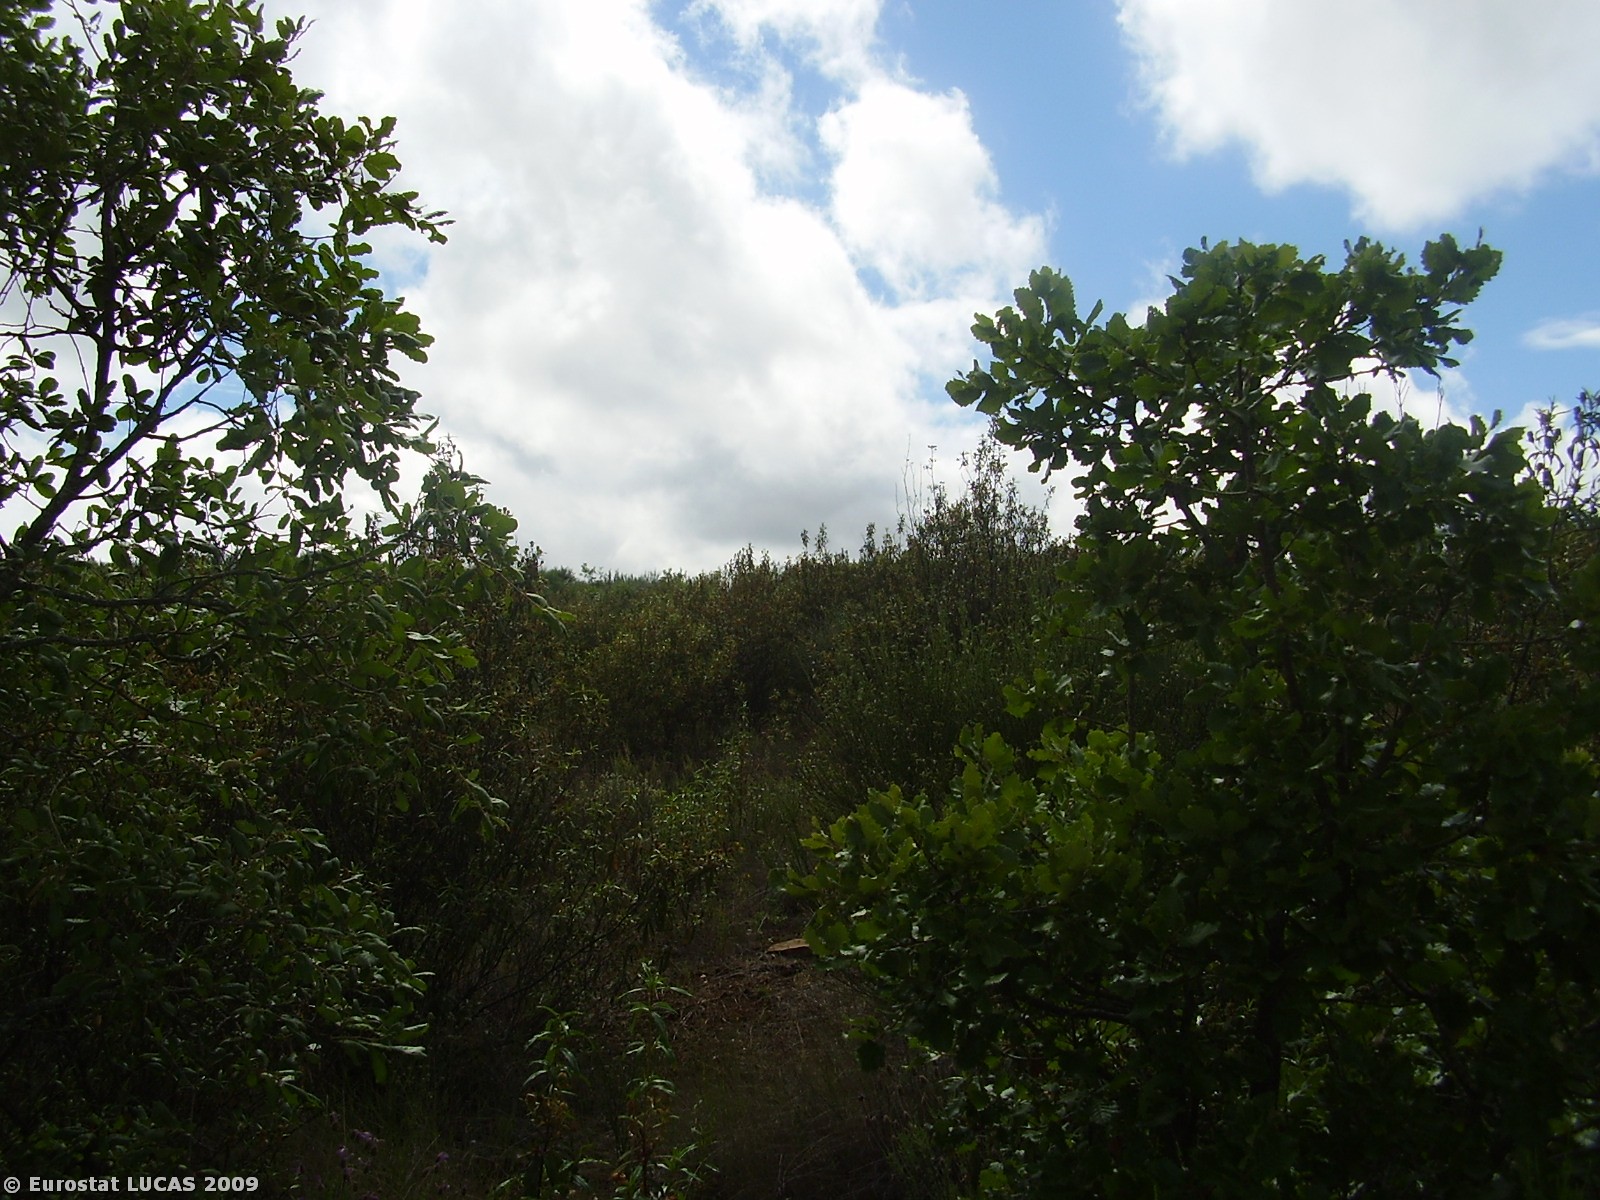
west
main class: Shrubland
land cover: Shrubland with sparse tree cover
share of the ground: > 75 %
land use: Nature reserves
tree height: > 5 m
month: June
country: PT
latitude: 41.5460
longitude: -6.8344
